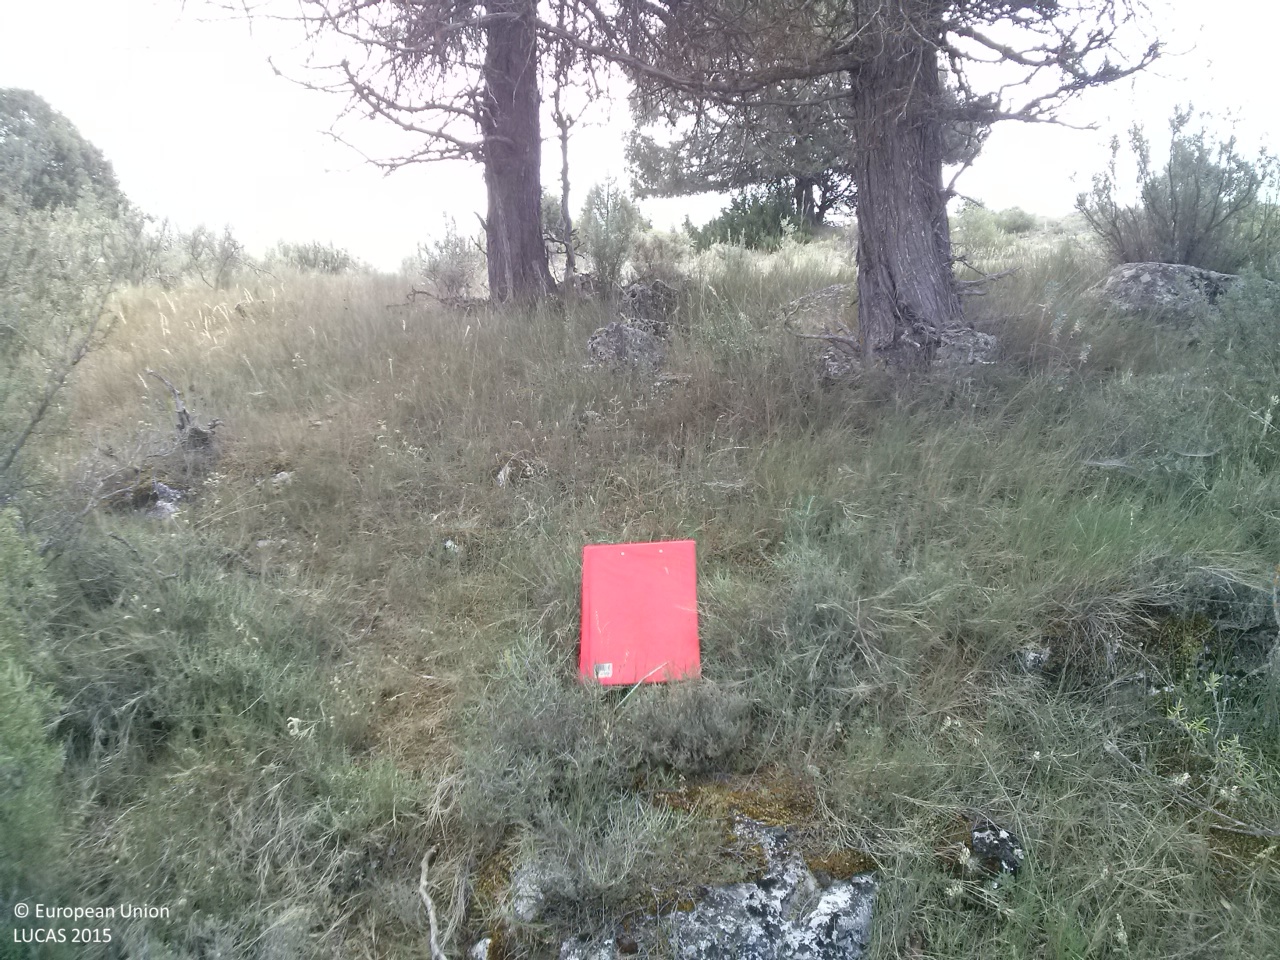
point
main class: Woodland
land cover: Other coniferous woodland
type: coniferous forest of the mediterranean region
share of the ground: 10 - 25 %
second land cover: Shrubland without tree cover
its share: 50 - 75 %
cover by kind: shrubs 60 %, coniferous forest trees 20 %, herbaceous plants 20 %
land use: Forestry
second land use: Agriculture (excluding fallow land and kitchen gardens)
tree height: > 5 m
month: June
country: ES
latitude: 39.9640
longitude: -1.8716
